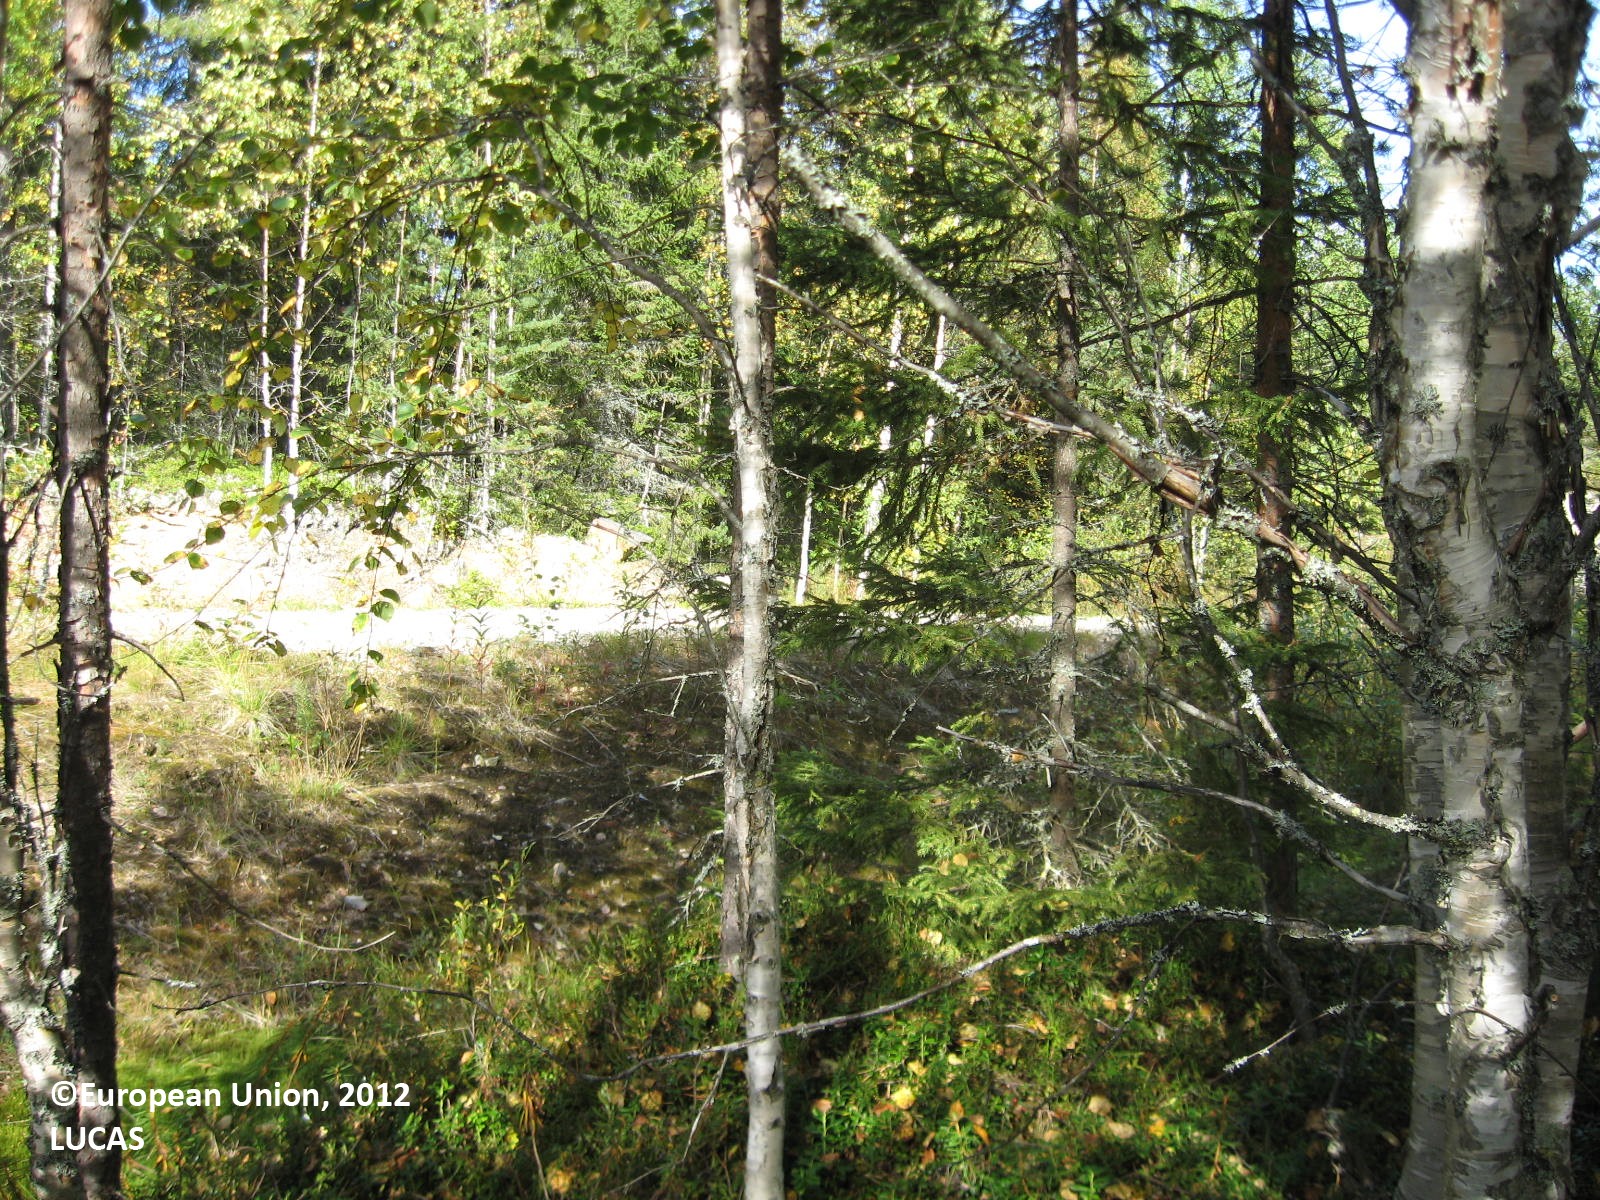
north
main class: Woodland
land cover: Pine dominated mixed woodland
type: boreal forest
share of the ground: > 75 %
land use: Forestry
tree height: > 5 m
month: August
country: FI
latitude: 63.9251
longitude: 28.6854
